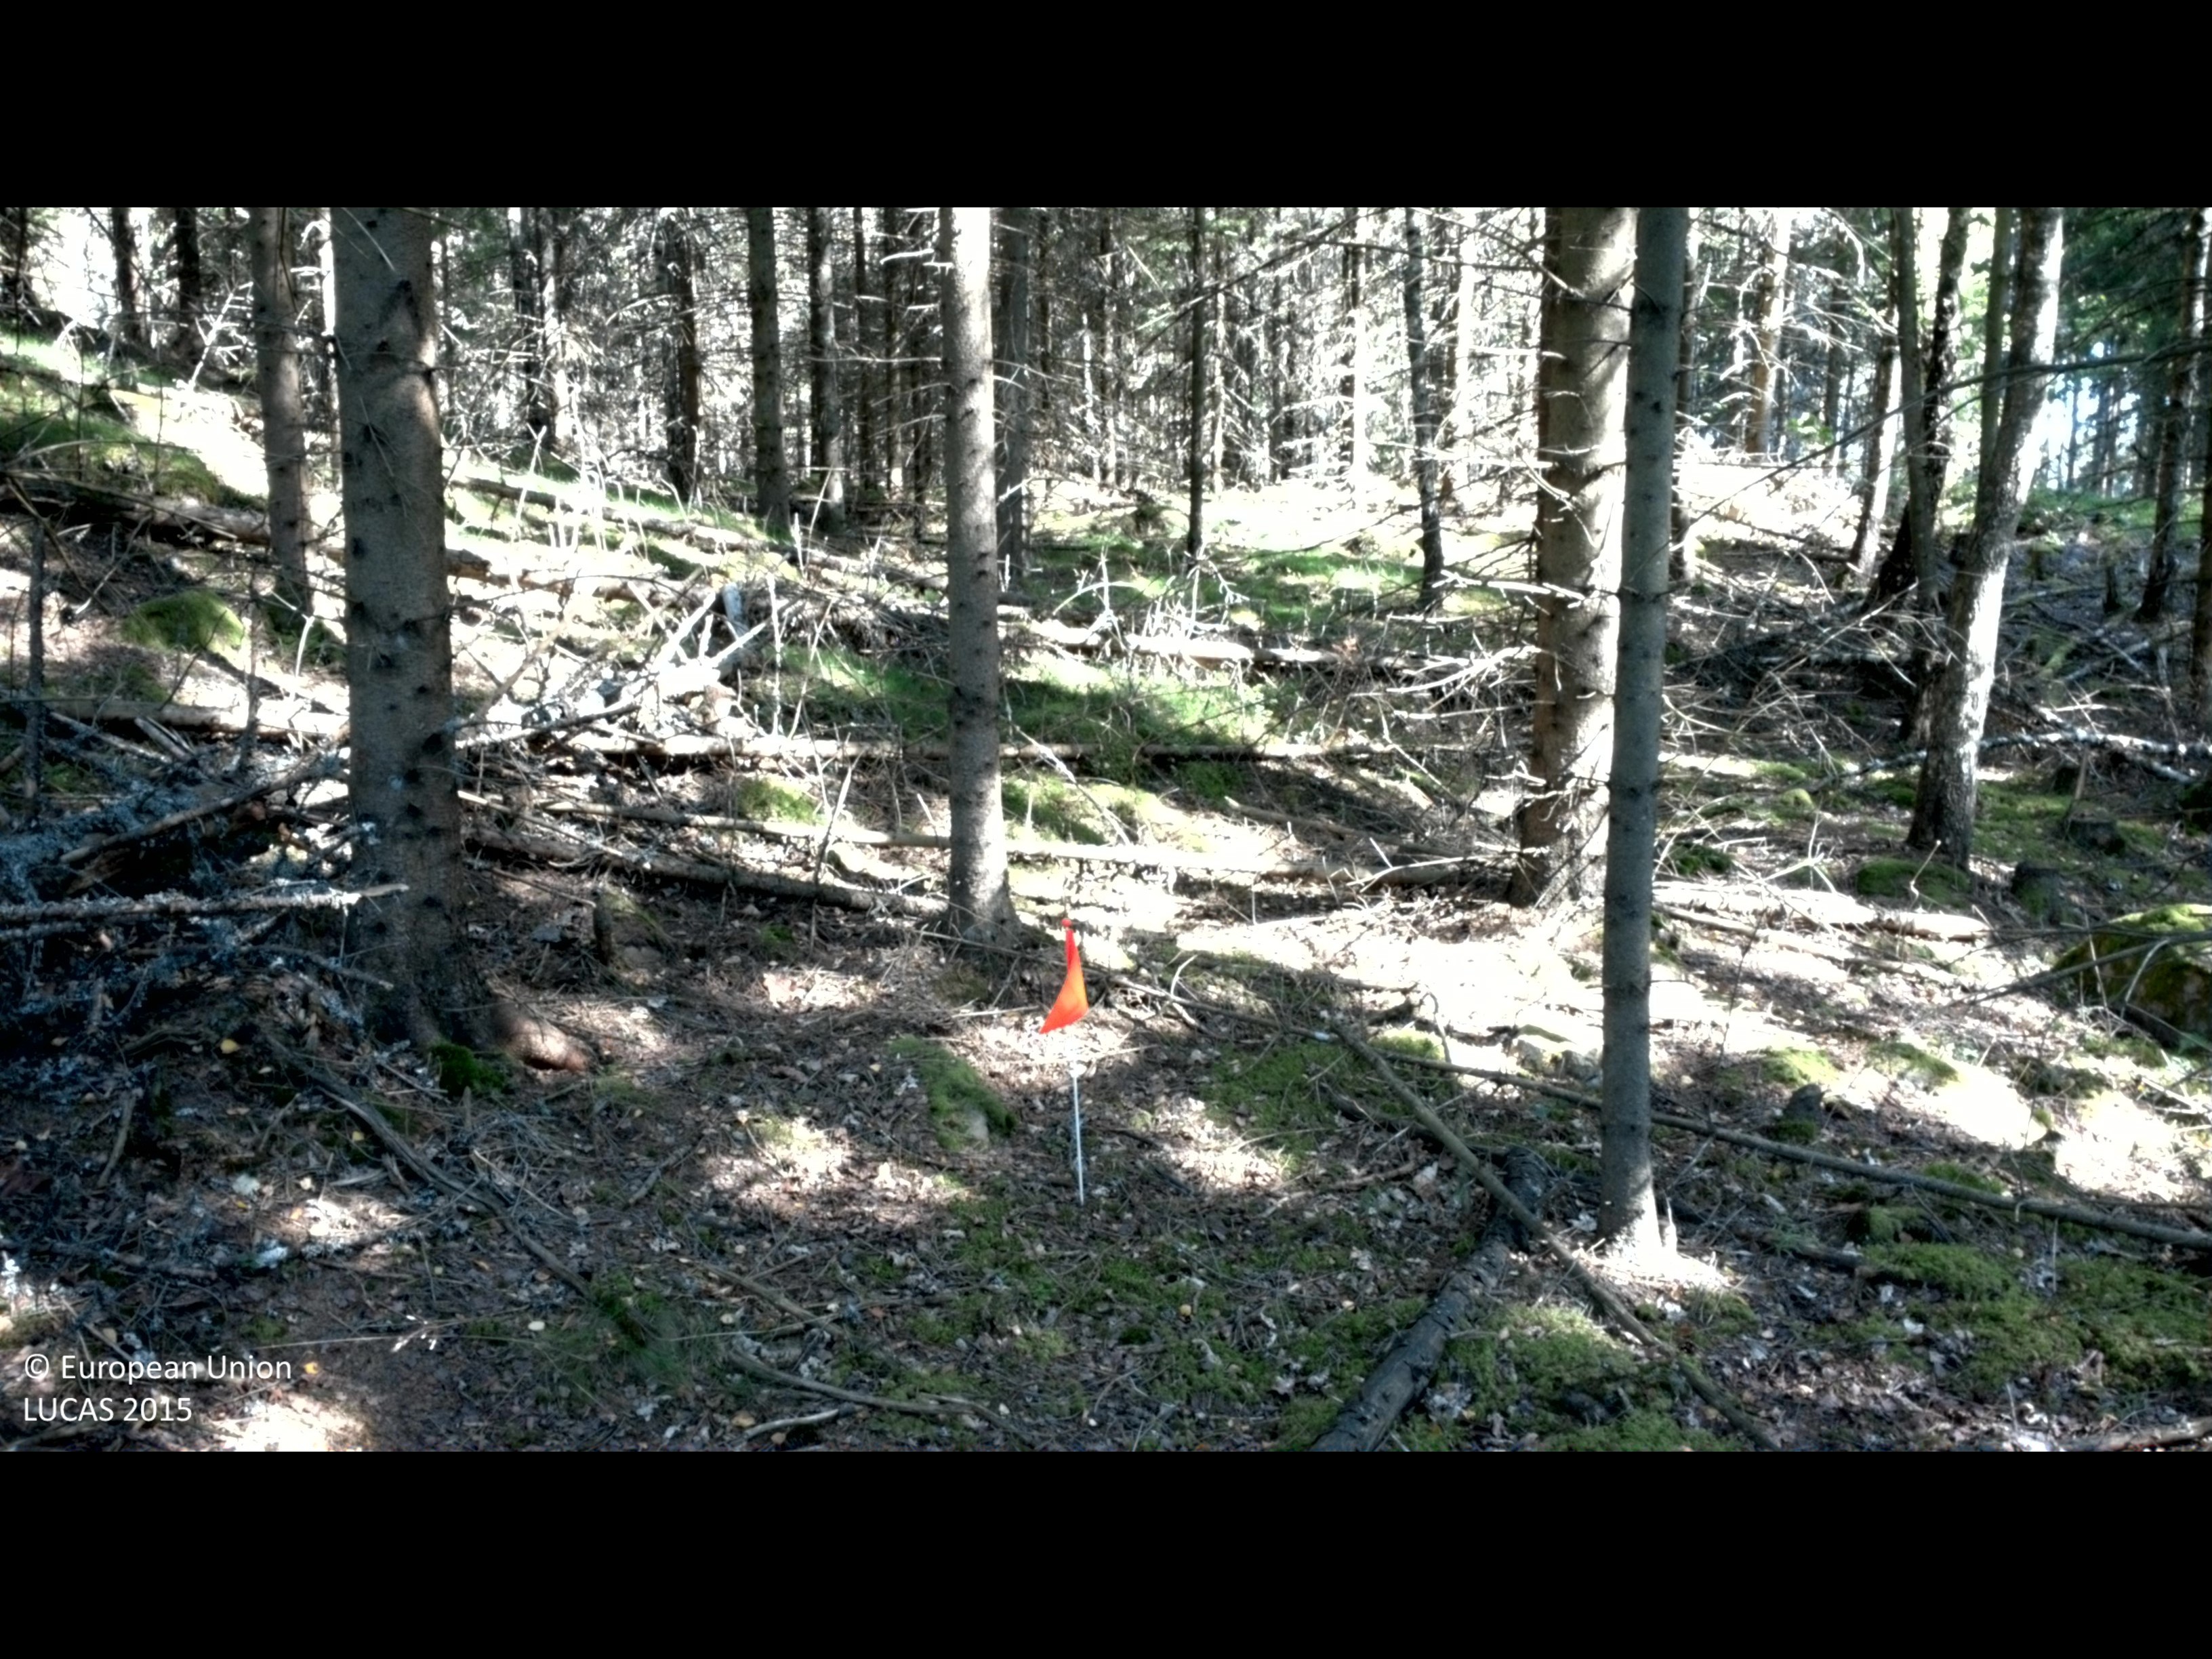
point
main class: Woodland
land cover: Spruce dominated mixed woodland
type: boreal forest
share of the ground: > 75 %
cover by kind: coniferous forest trees 50 %, broadleaved forest trees 25 %, shrubs 15 %, lichens and mosses 10 %
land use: Forestry
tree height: > 5 m
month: August
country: SE
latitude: 57.0116
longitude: 13.8662
